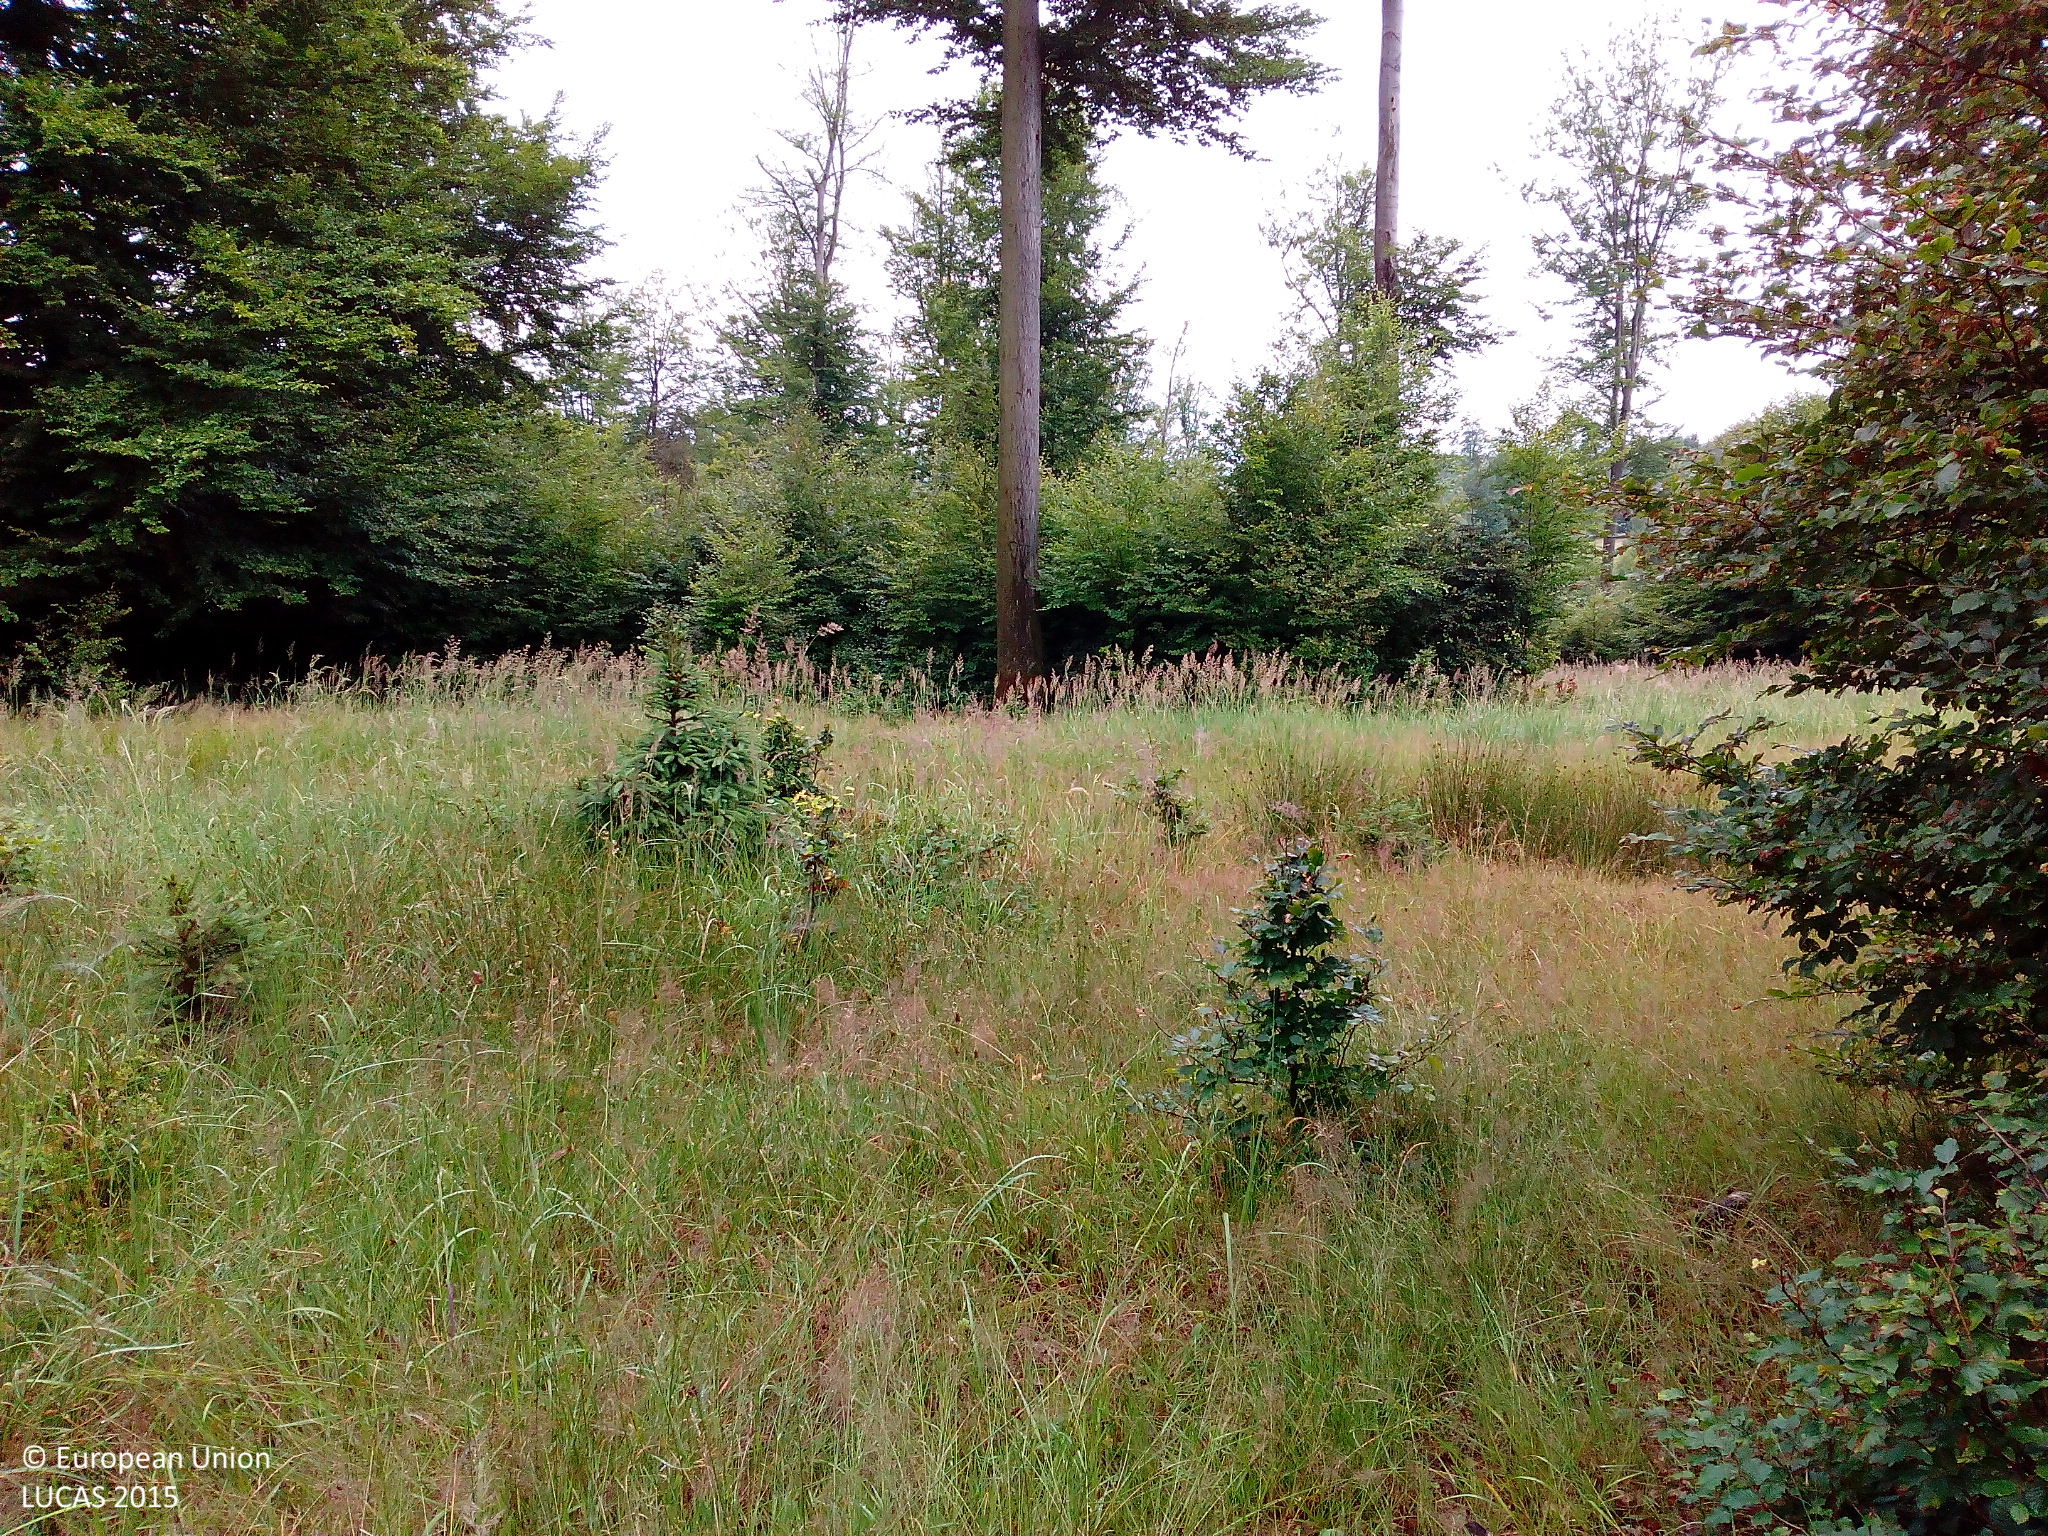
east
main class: Woodland
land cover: Broadleaved woodland
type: beech forest
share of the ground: > 75 %
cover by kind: broadleaved forest trees 95 %, herbaceous plants 5 %
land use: Forestry
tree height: > 5 m
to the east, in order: Broadleaved woodland; Tracks; Broadleaved woodland
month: July
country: DE
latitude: 50.9034
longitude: 9.9005
